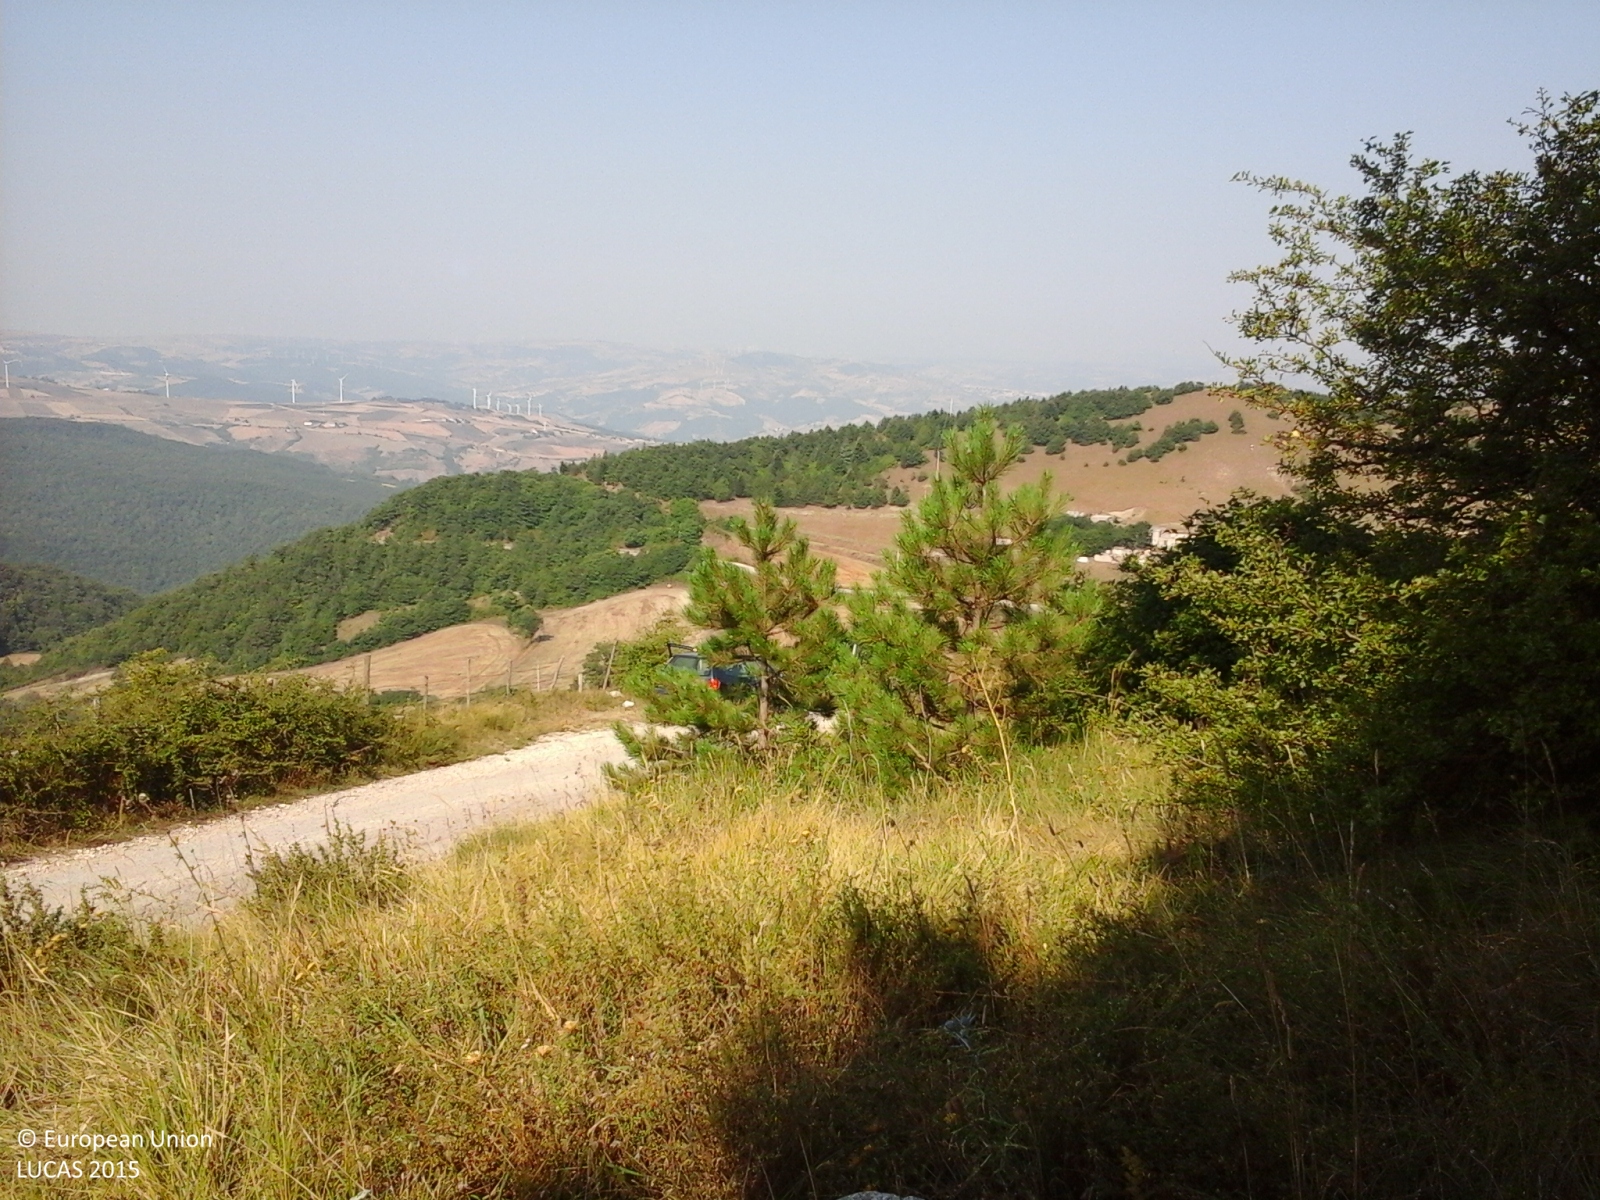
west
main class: Woodland
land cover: Pine dominated coniferous woodland
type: coniferous forest of the mediterranean region
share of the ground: > 75 %
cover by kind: coniferous forest trees 95 %, herbaceous plants 5 %
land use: Semi-natural and natural areas not in use
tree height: > 5 m
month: August
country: IT
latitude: 41.3652
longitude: 15.1346
